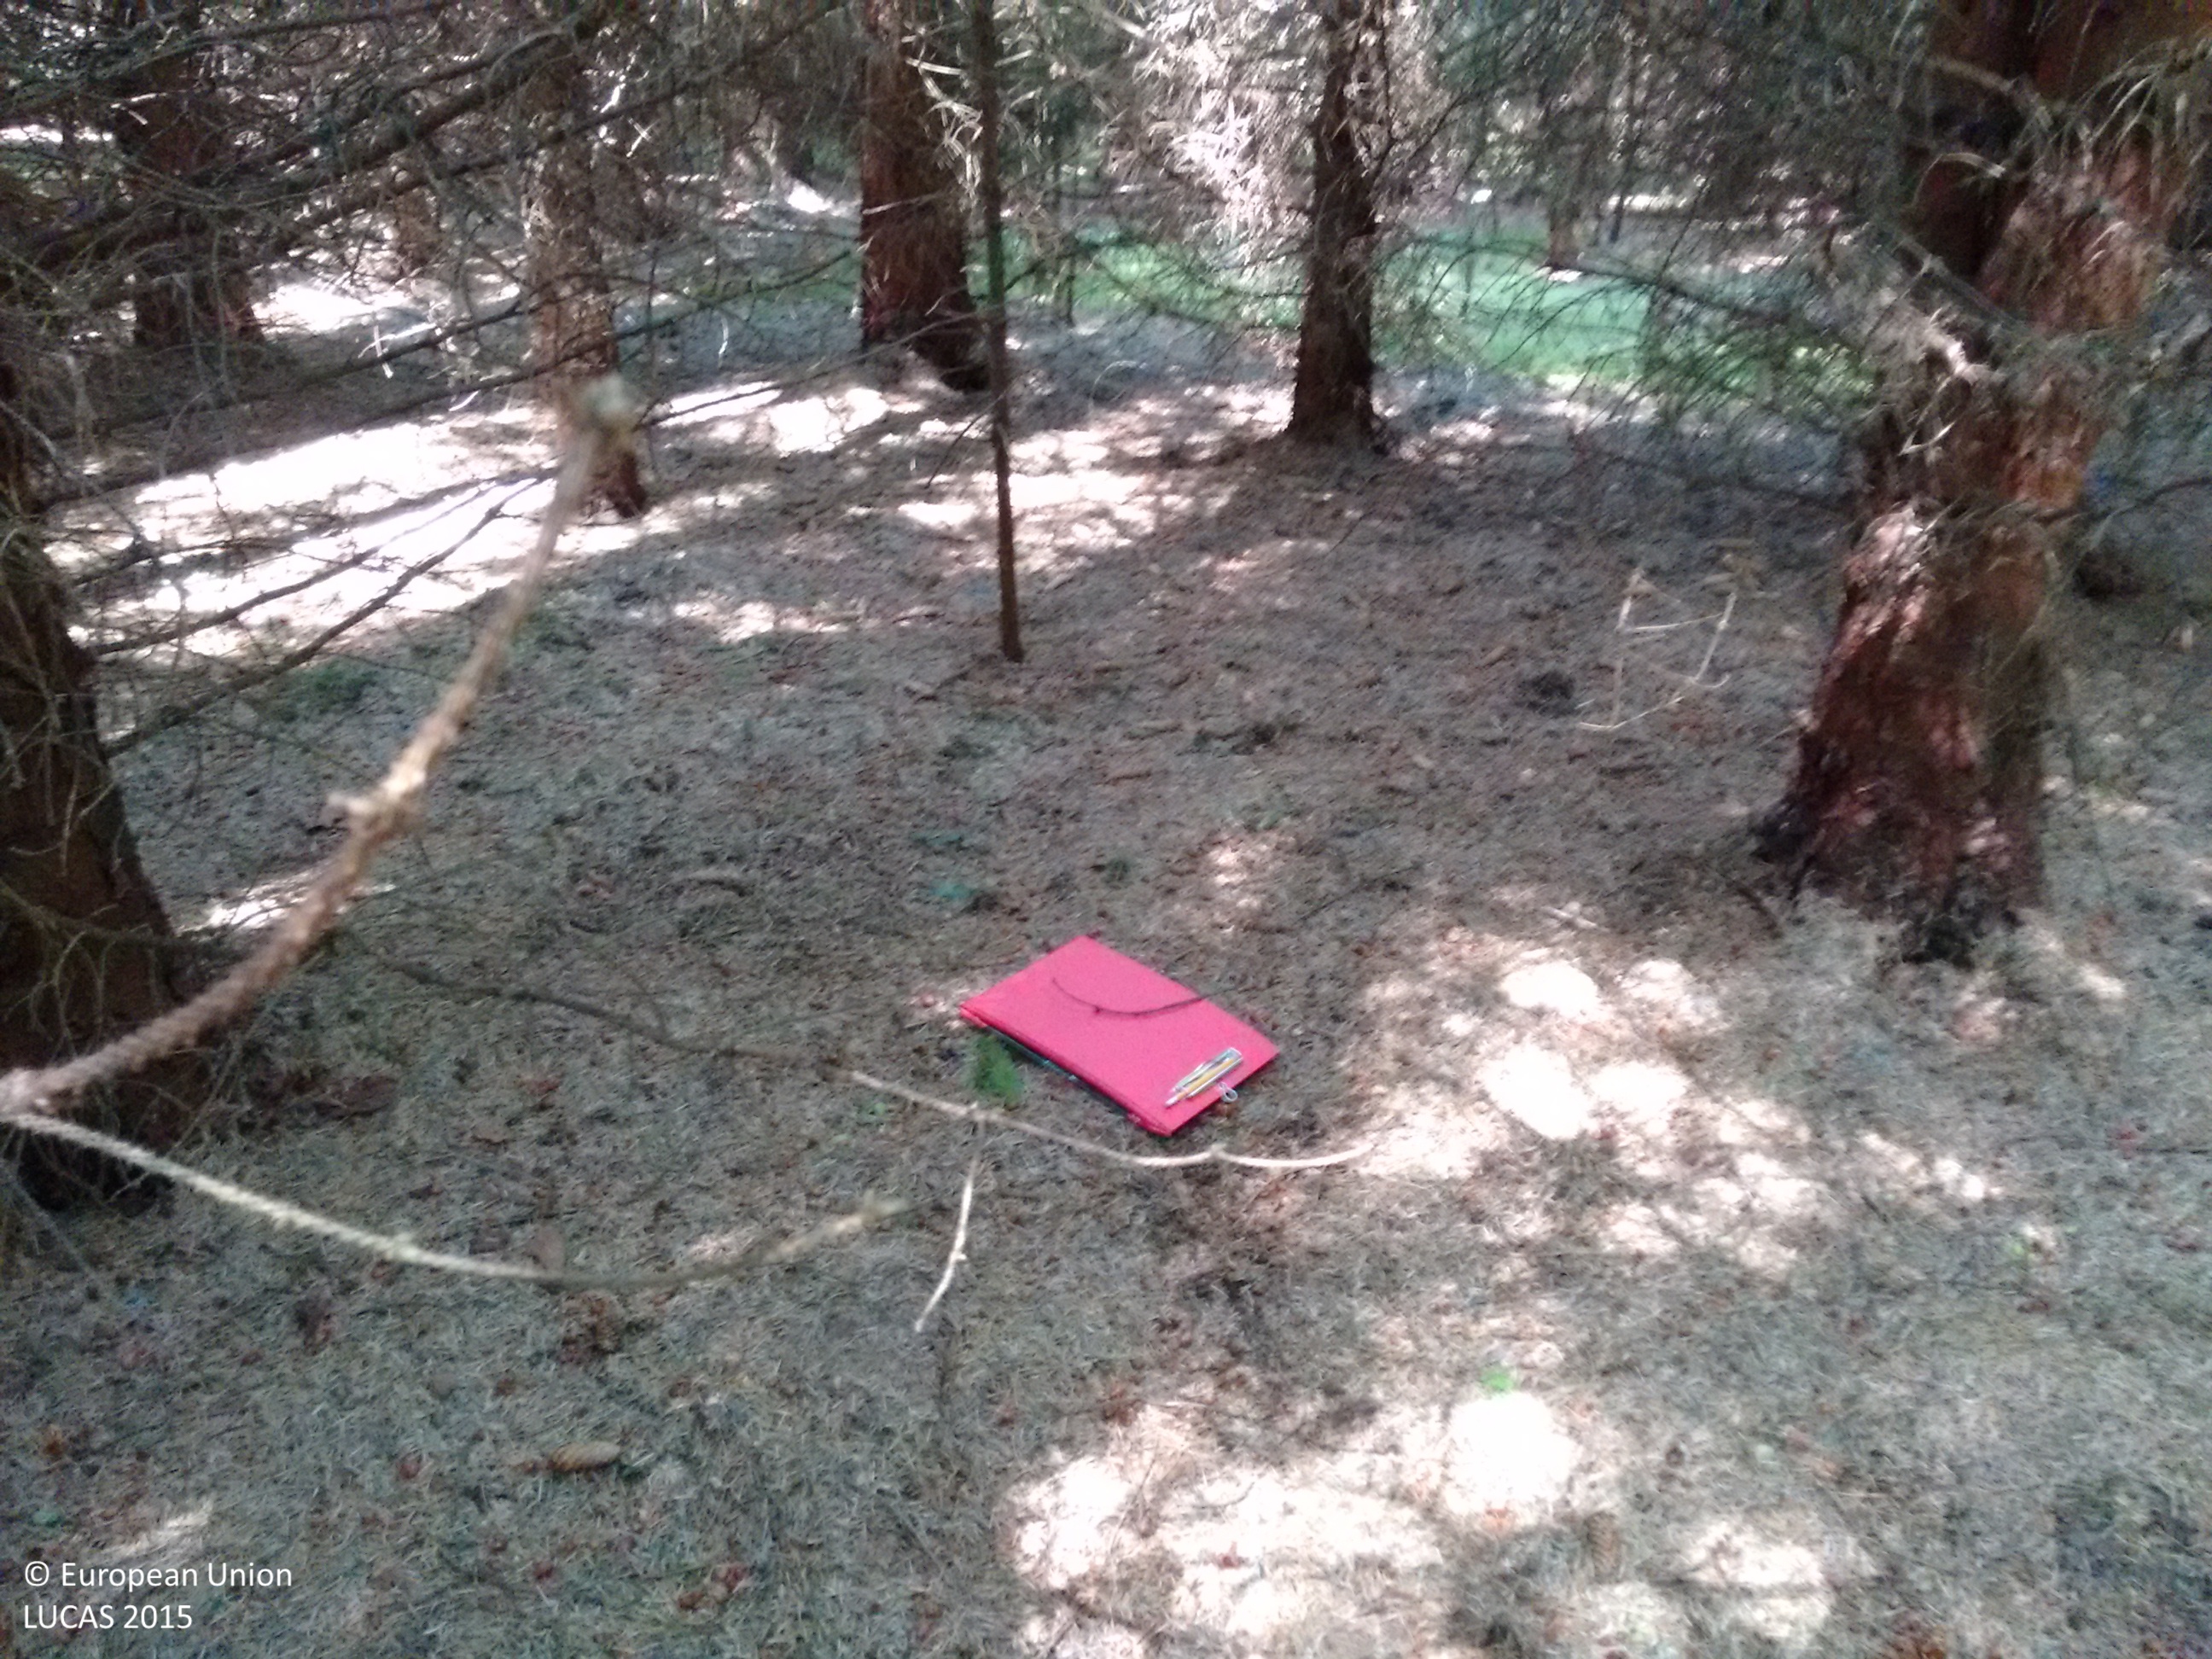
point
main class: Woodland
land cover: Spruce dominated coniferous woodland
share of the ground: > 75 %
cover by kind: coniferous forest trees 80 %, herbaceous plants 10 %, lichens and mosses 10 %
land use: Forestry
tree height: < 5 m
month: July
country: GB
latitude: 55.6070
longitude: -3.7510
